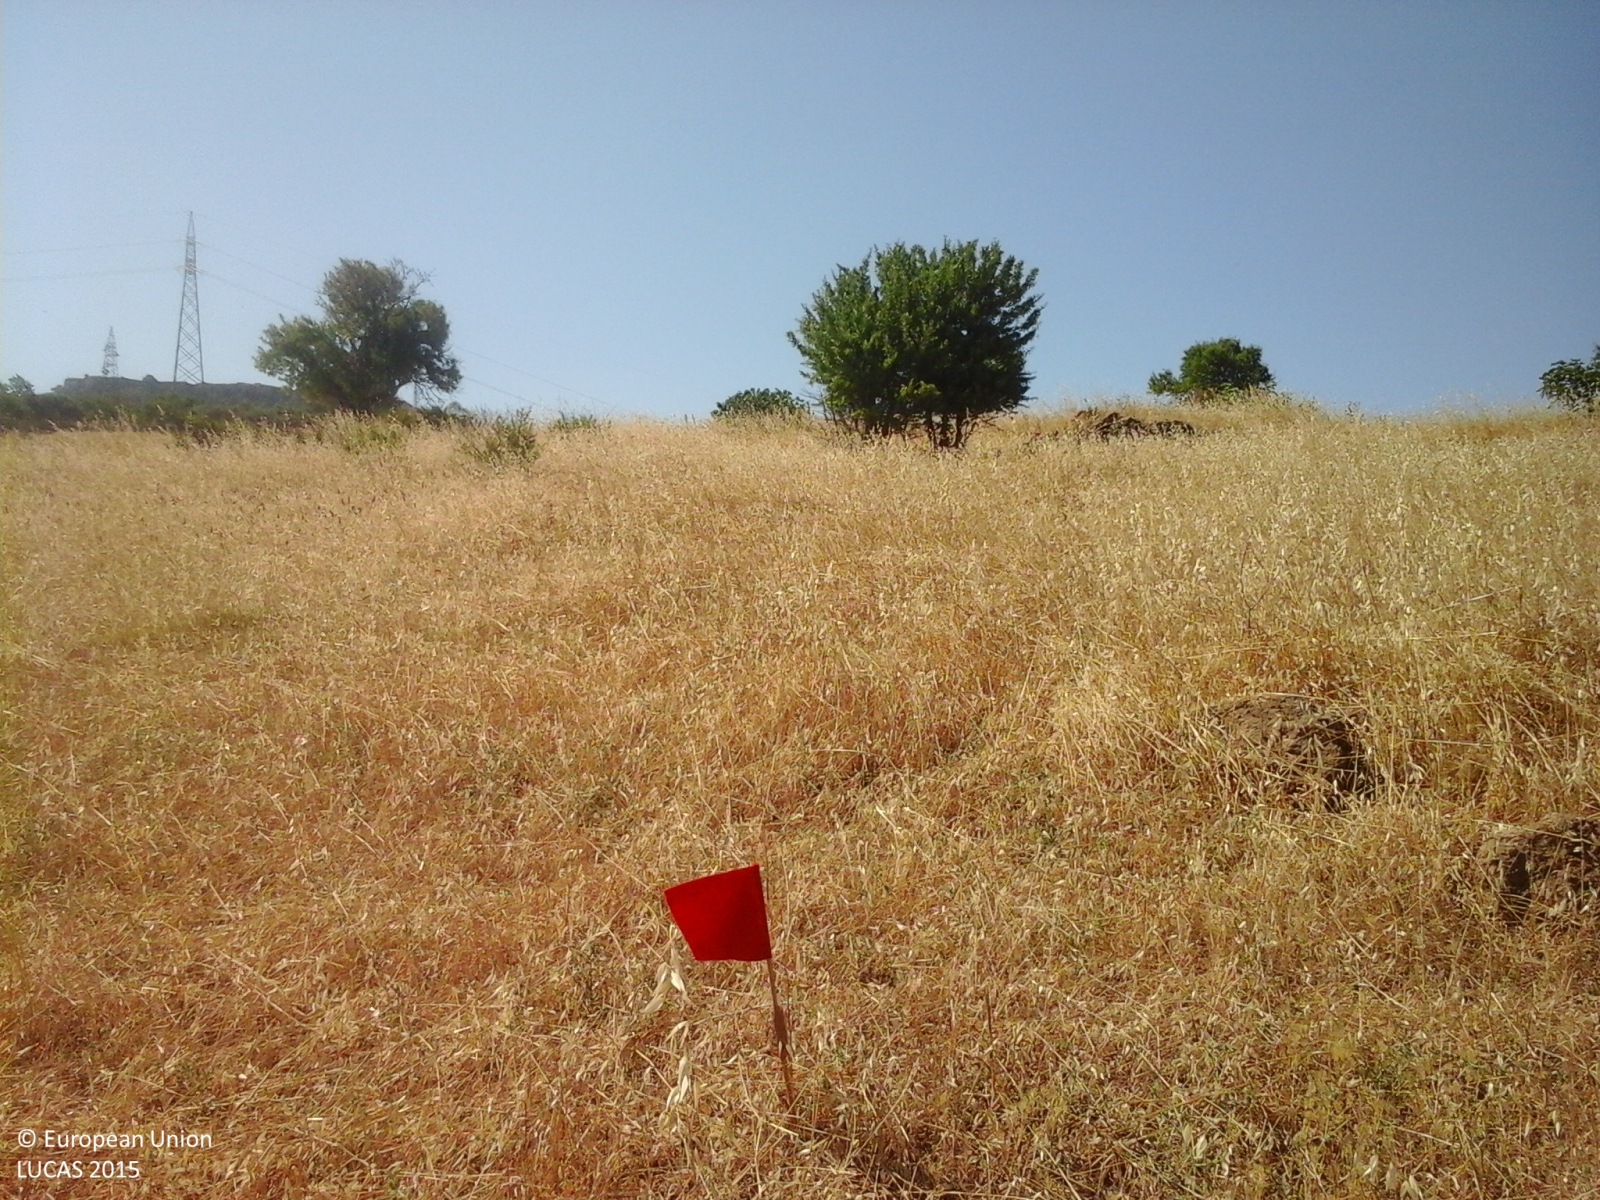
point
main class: Grassland
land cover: Spontaneously vegetated surfaces
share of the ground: > 75 %
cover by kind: herbaceous plants 100 %
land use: Fallow land
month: July
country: IT
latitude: 37.3187
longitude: 13.5270
